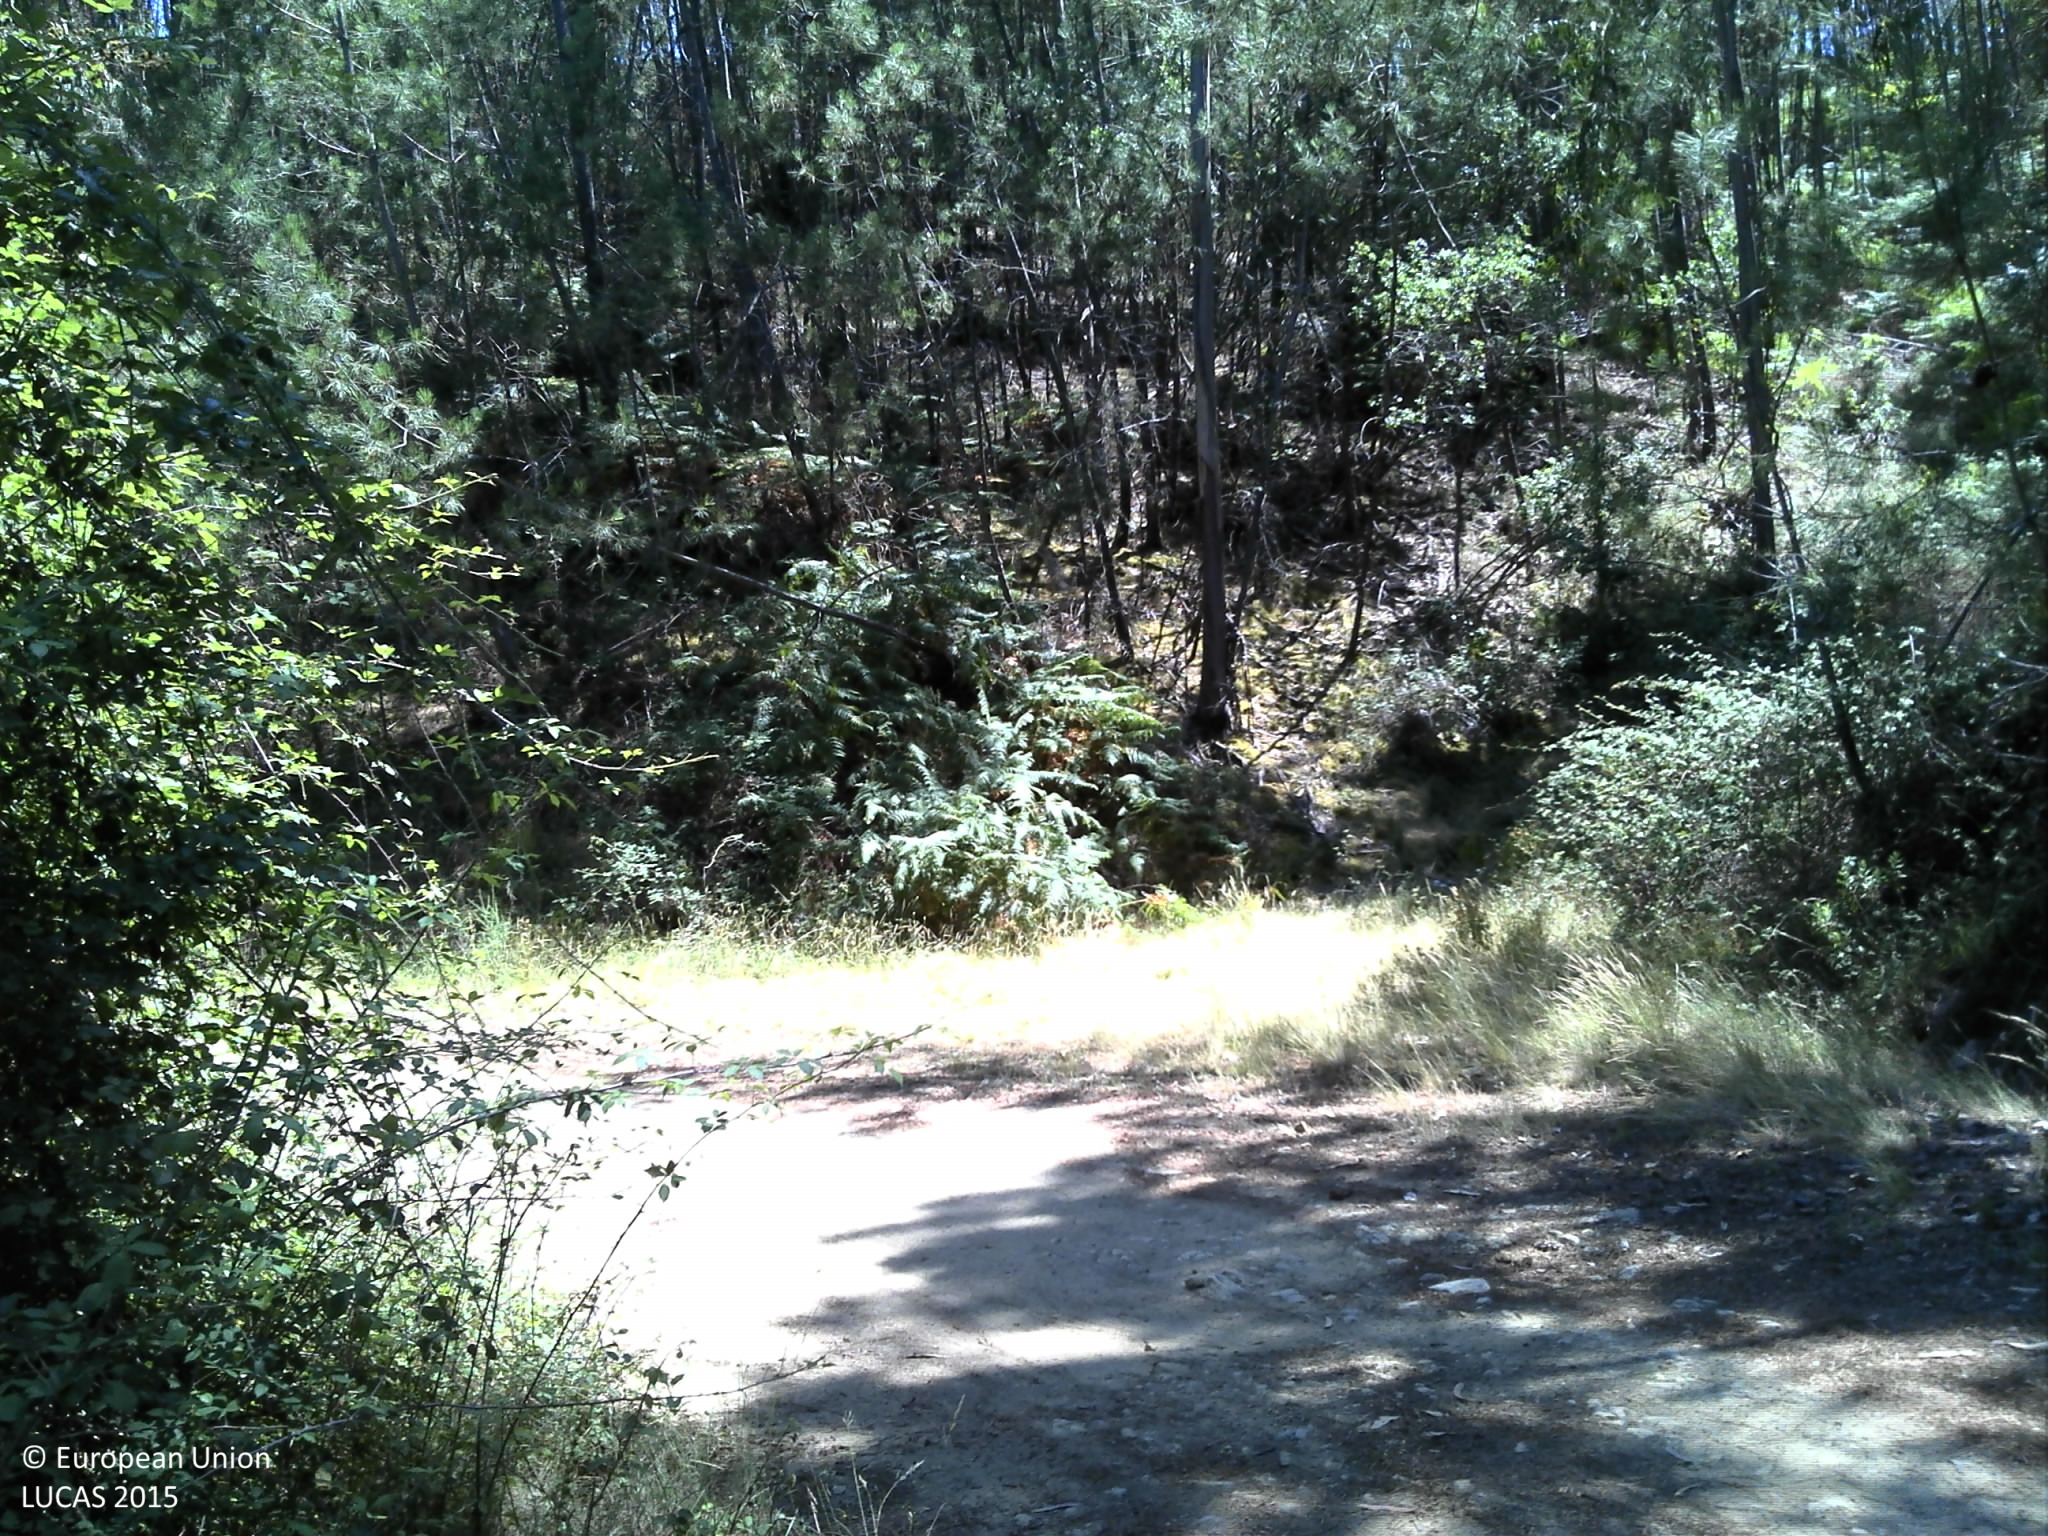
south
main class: Woodland
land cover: Pine dominated coniferous woodland
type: coniferous forest of the mediterranean region
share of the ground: 10 - 25 %
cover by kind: shrubs 80 %, coniferous forest trees 15 %, unconsolidated bare surface 5 %
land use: Forestry
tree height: > 5 m
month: July
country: PT
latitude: 39.9309
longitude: -8.1257
